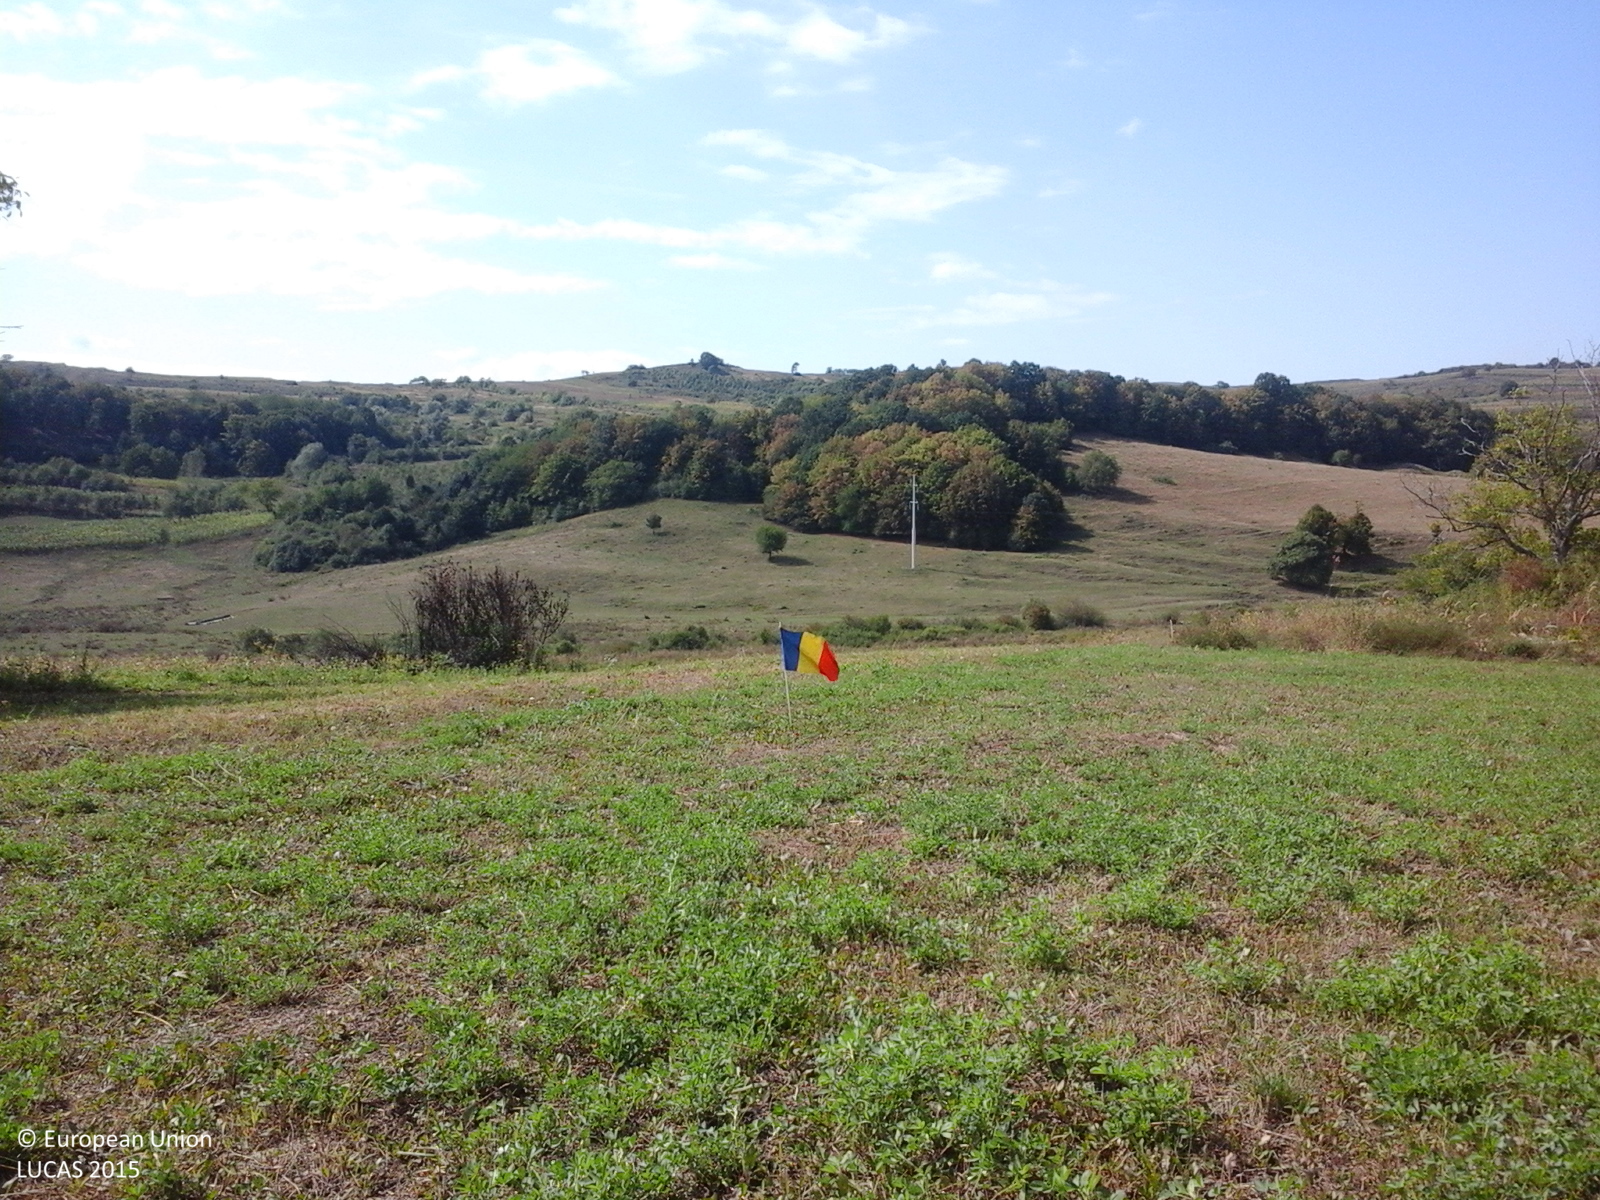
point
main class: Cropland
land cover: Lucerne
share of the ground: > 75 %
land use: Agriculture (excluding fallow land and kitchen gardens)
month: September
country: RO
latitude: 47.3510
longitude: 23.2131
